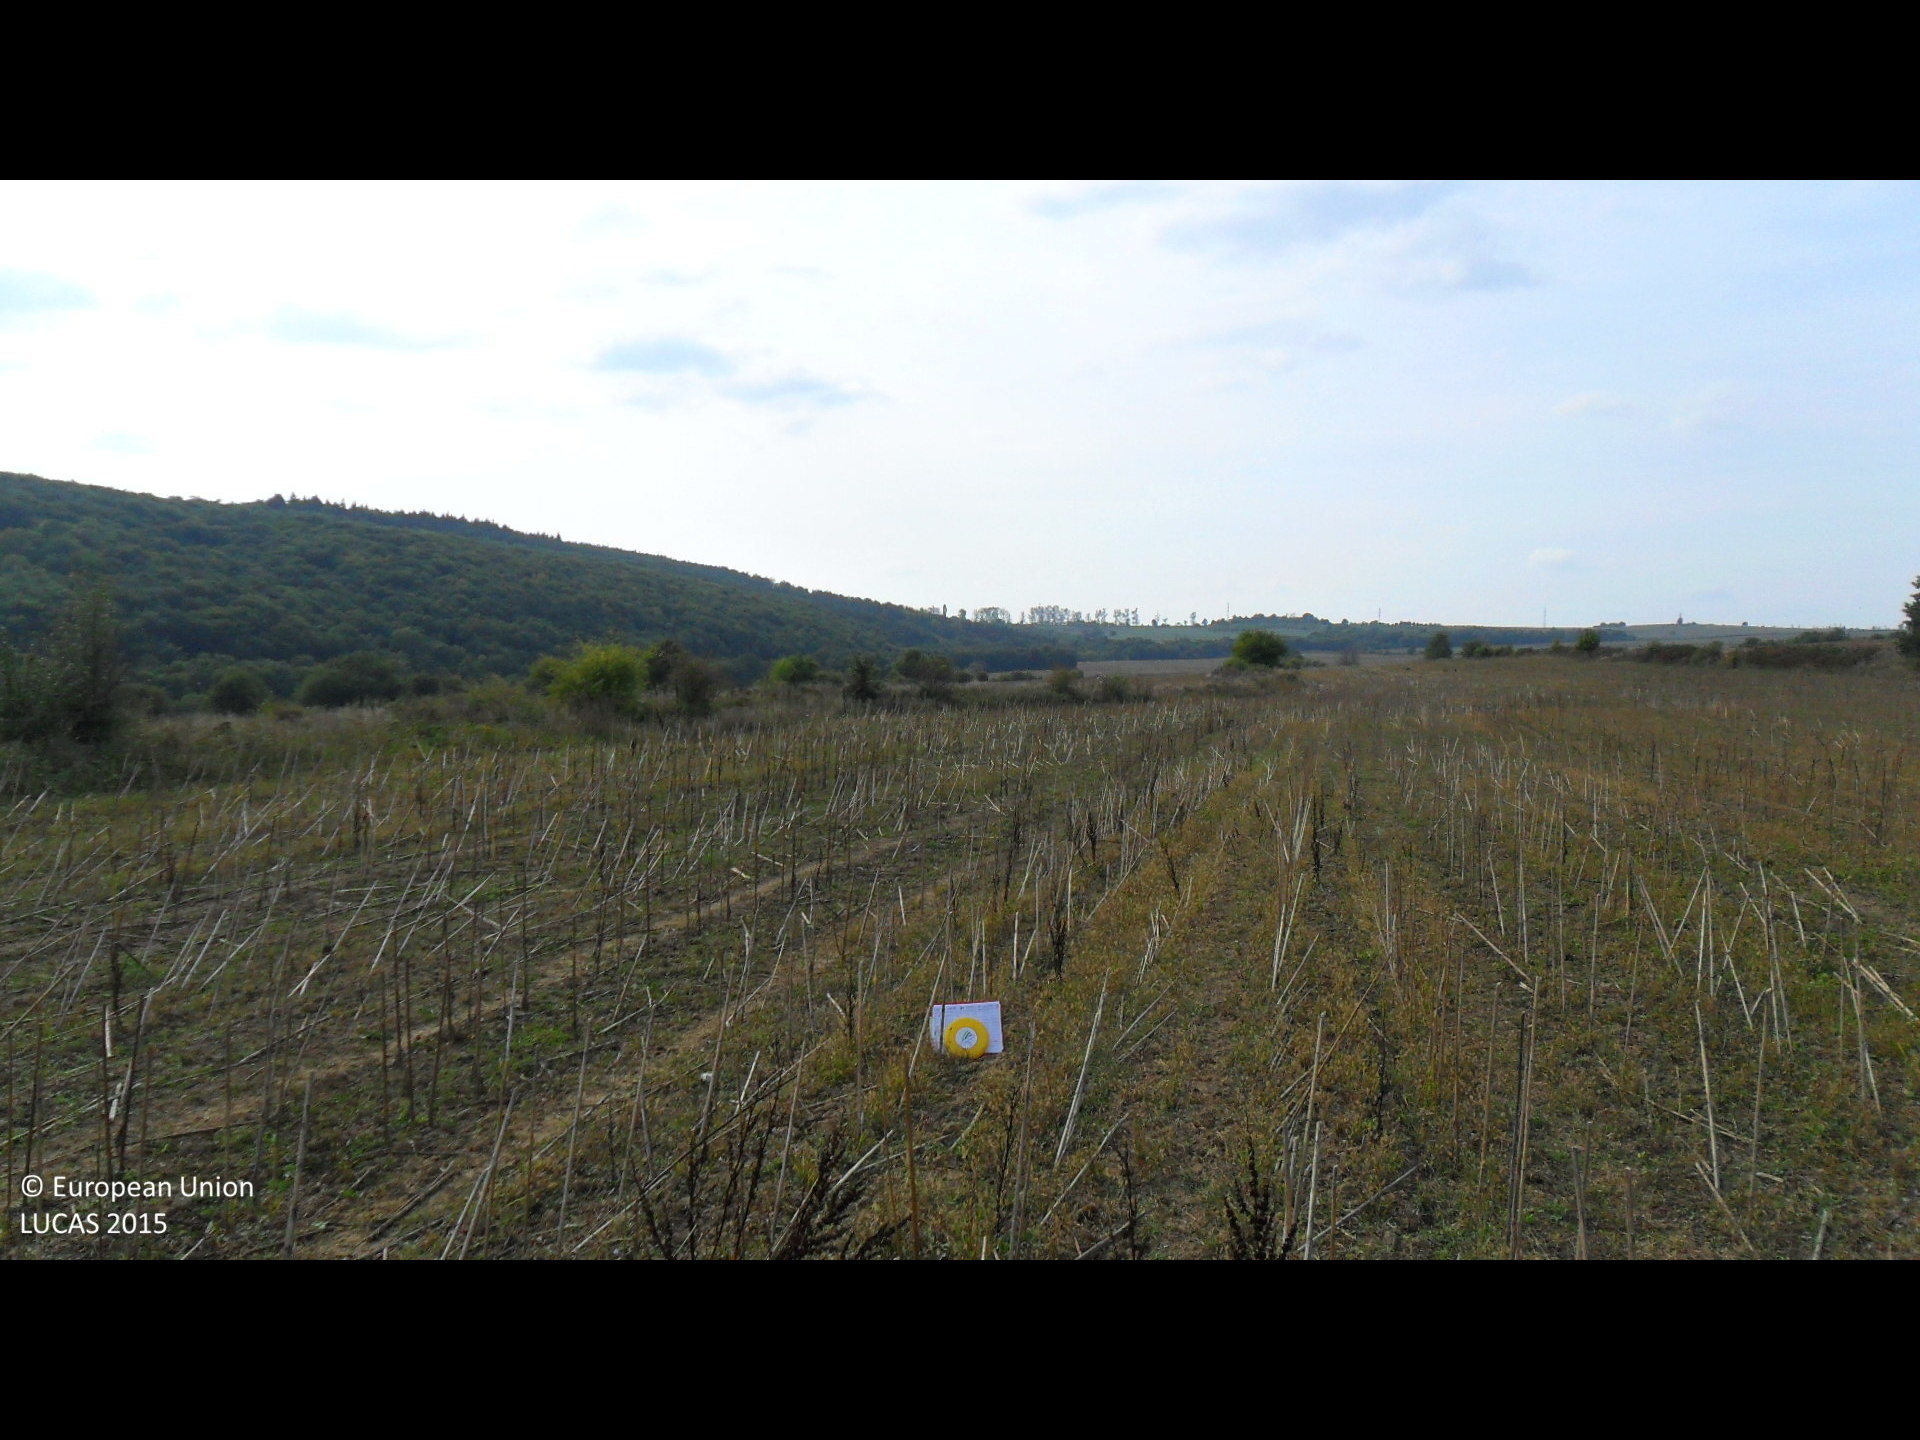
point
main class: Cropland
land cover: Sunflower
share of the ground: 25 - 50 %
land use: Agriculture (excluding fallow land and kitchen gardens)
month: September
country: BG
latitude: 43.0472
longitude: 26.4372
